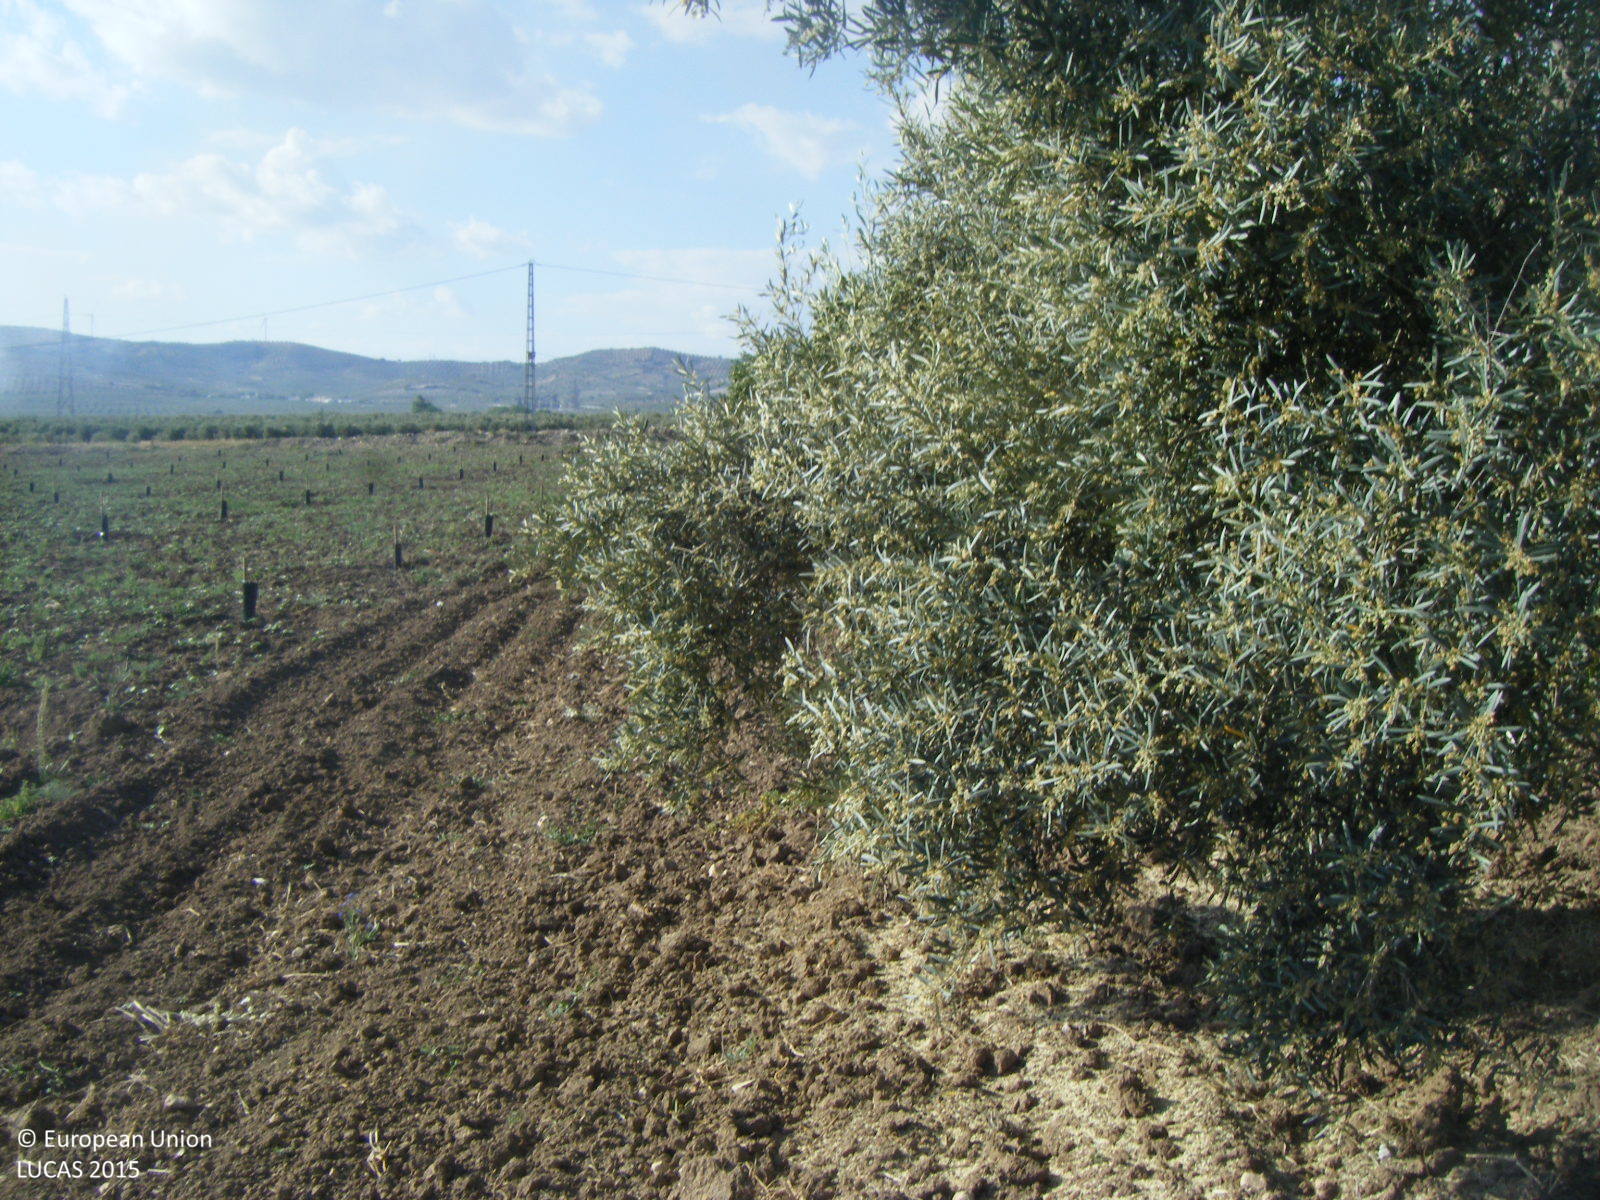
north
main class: Cropland
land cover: Olive groves
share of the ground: 25 - 50 %
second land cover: Other bare soil
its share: > 75 %
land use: Agriculture (excluding fallow land and kitchen gardens)
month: May
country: ES
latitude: 37.1034
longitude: -4.4106
